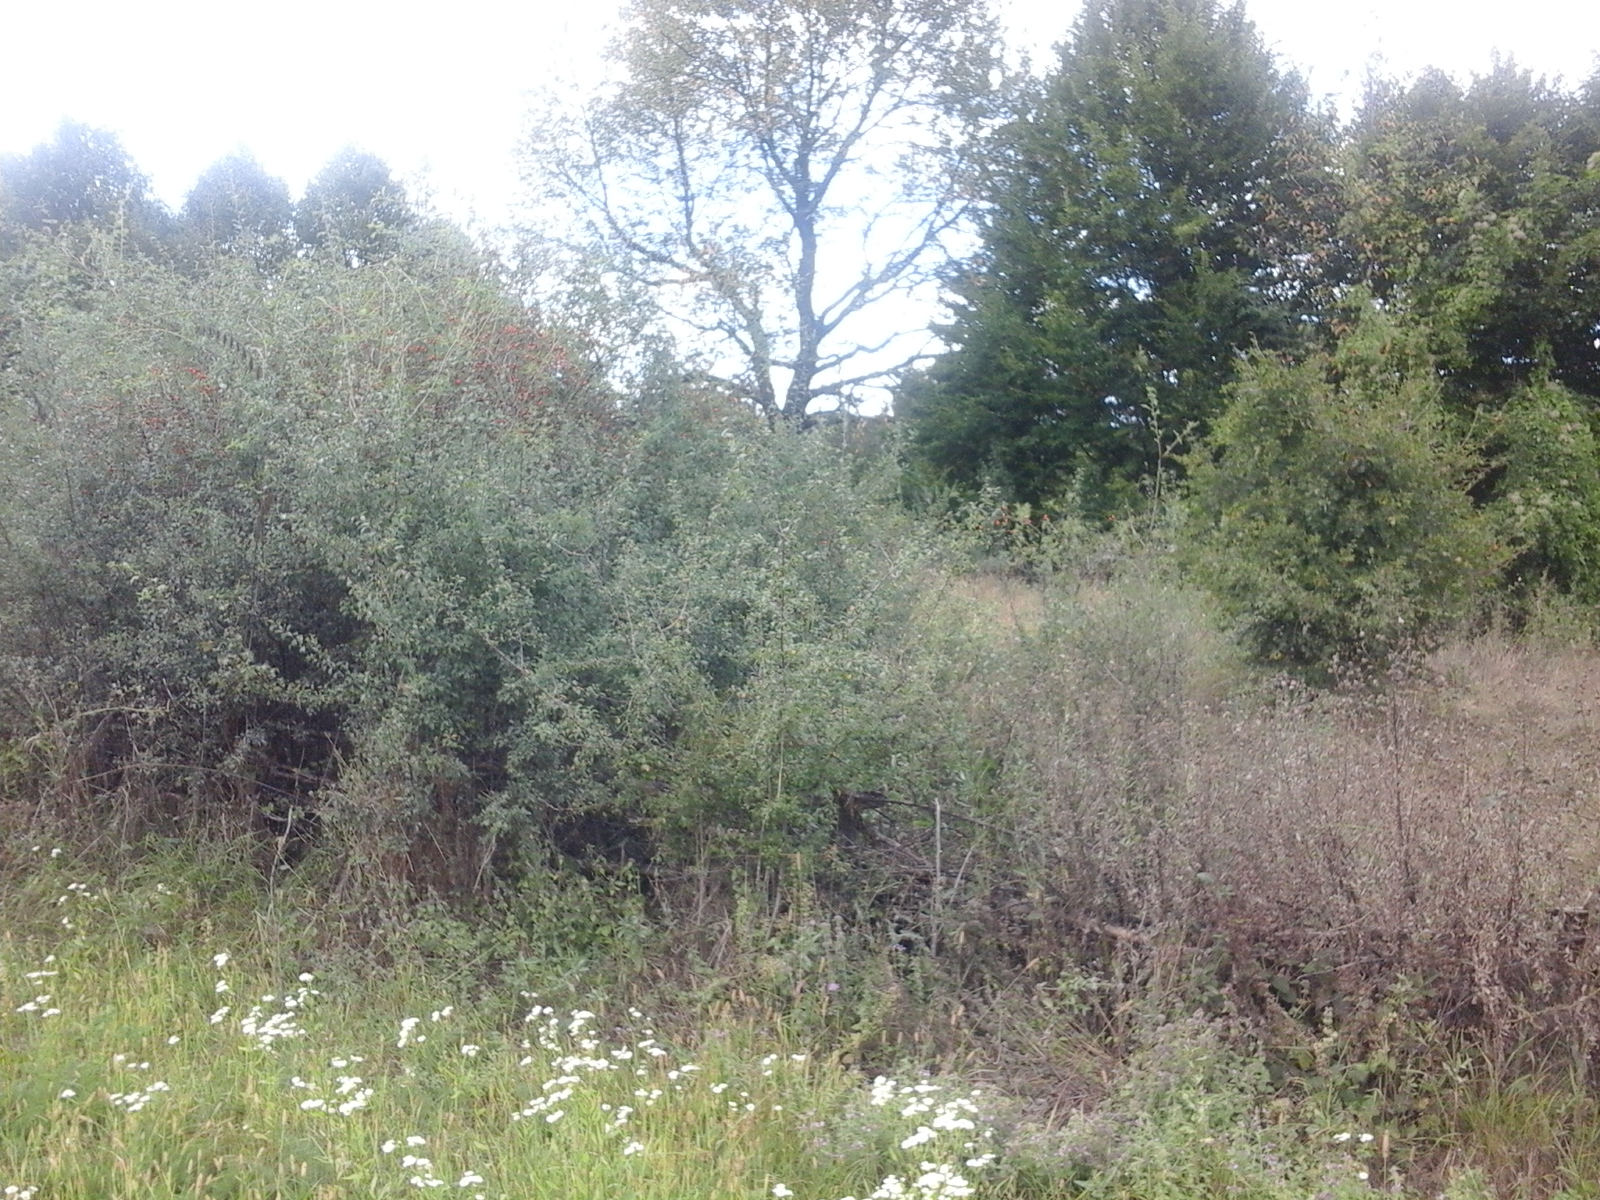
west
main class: Grassland
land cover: Grassland without tree/shrub cover
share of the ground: > 75 %
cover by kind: herbaceous plants 100 %
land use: Agriculture (excluding fallow land and kitchen gardens)
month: September
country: RO
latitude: 47.4303
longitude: 23.7466
